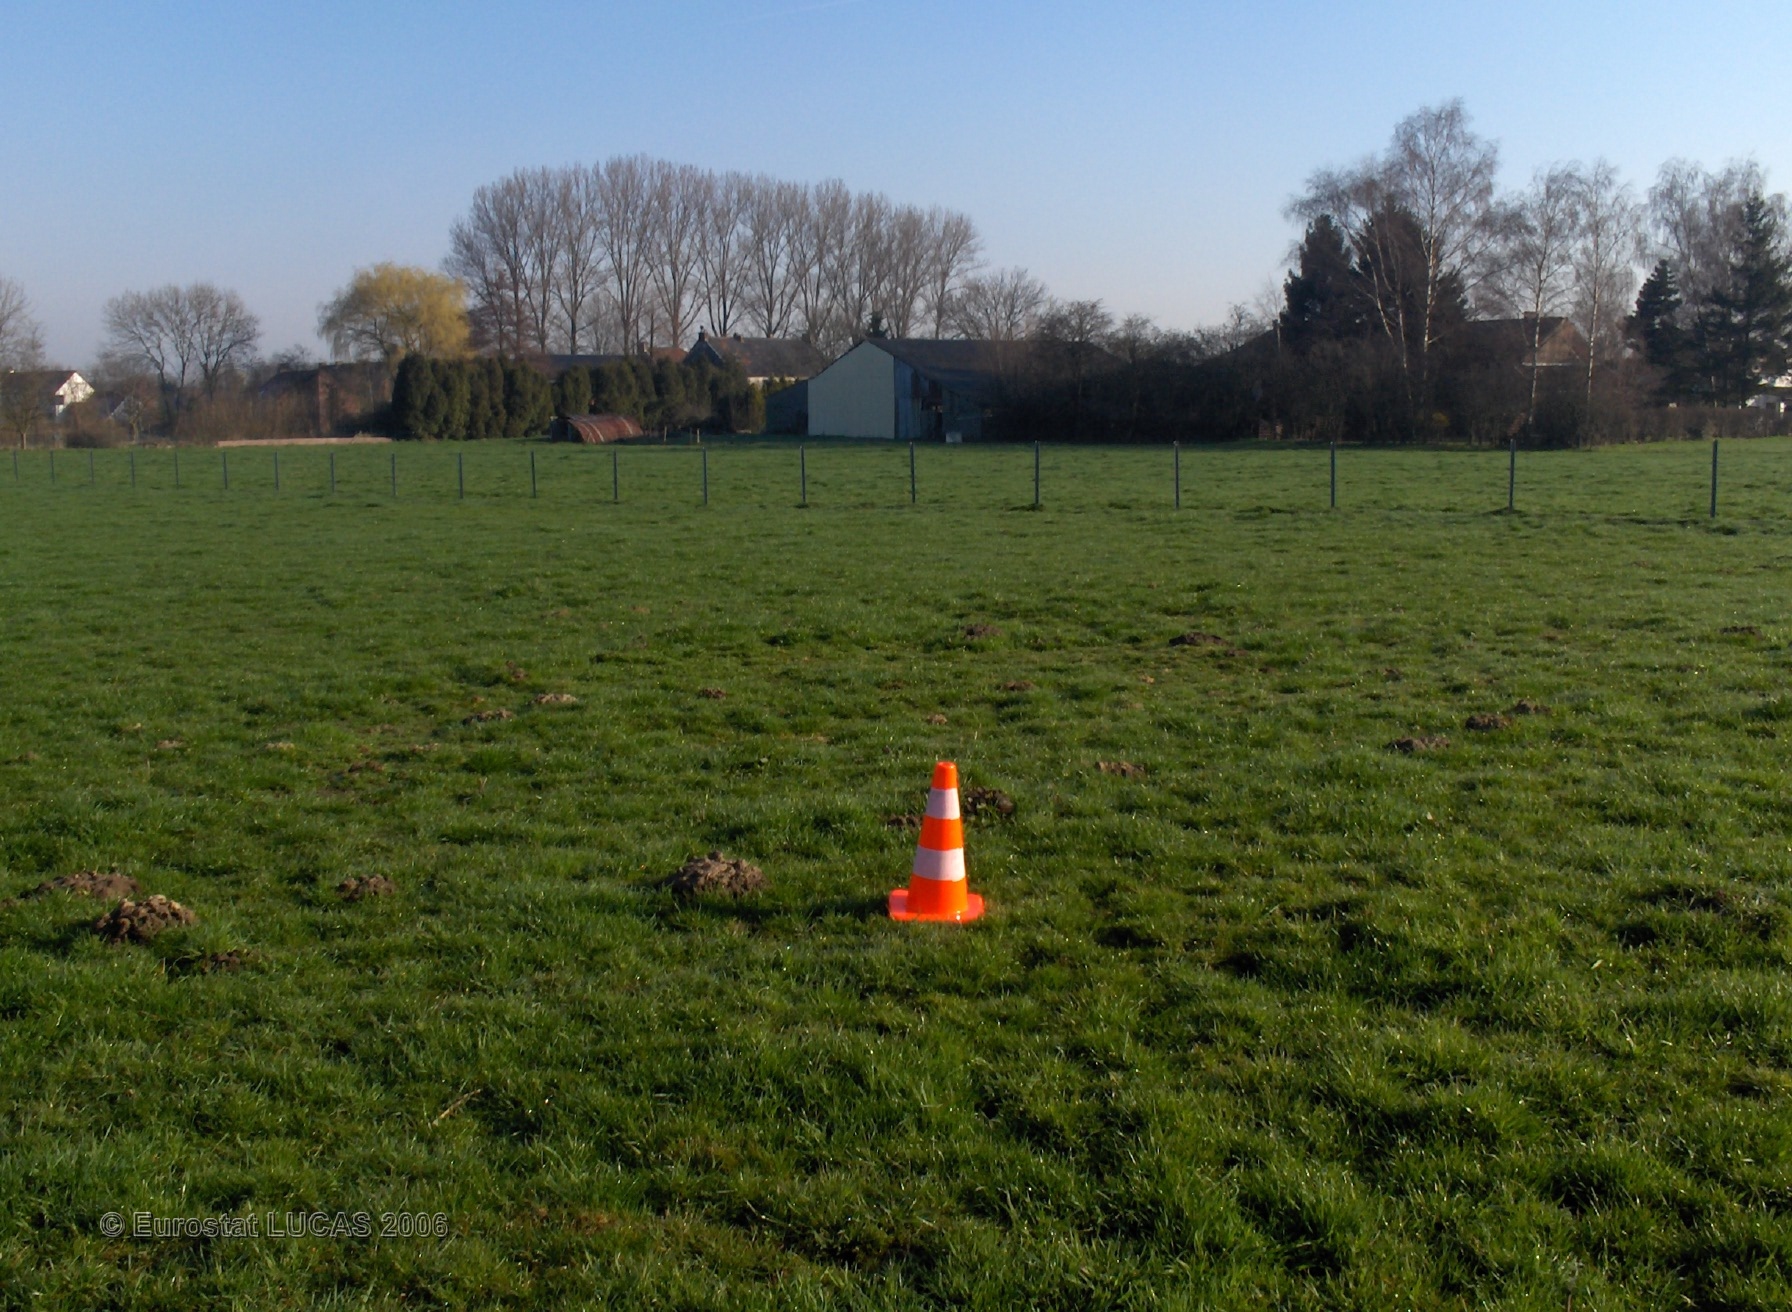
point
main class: Grassland
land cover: Grassland without tree/shrub cover
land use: Agriculture (excluding fallow land and kitchen gardens)
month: April
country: BE
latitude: 50.5013
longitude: 4.4832
